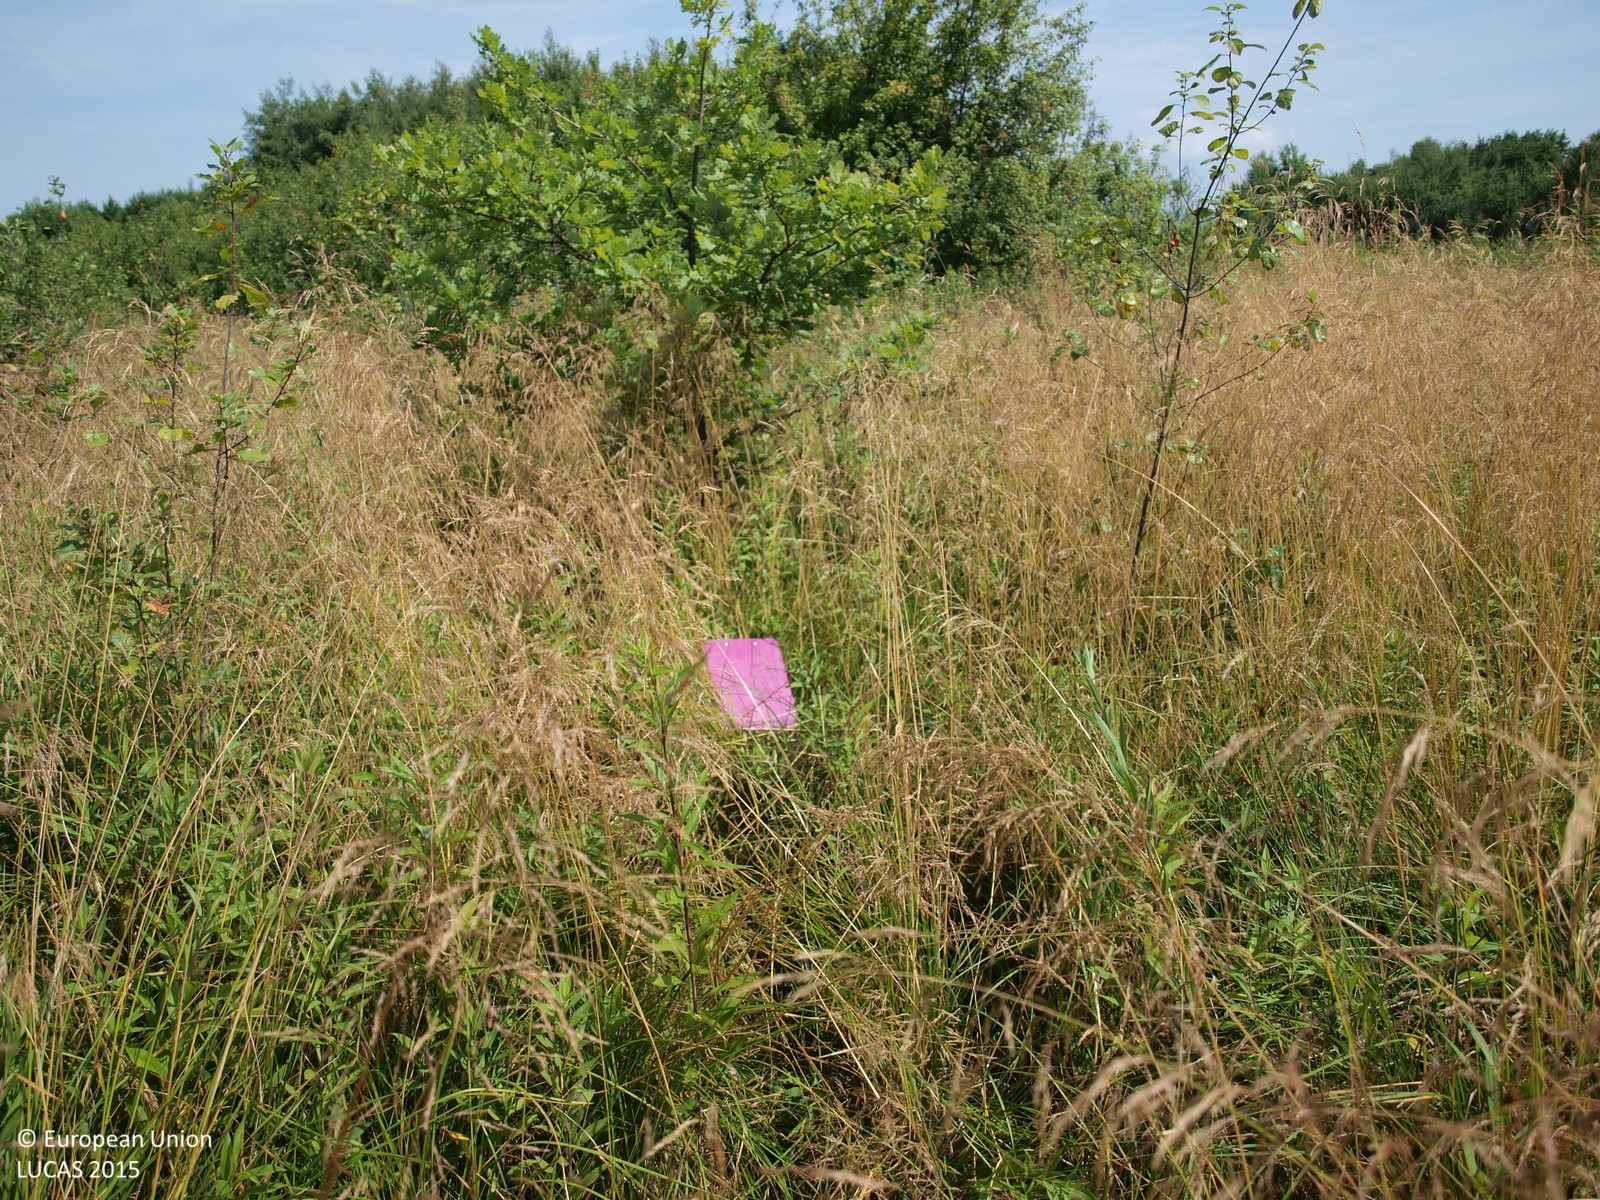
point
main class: Grassland
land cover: Grassland with sparse tree/shrub cover
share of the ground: > 75 %
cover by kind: herbaceous plants 90 %, broadleaved forest trees 5 %, shrubs 5 %
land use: Fallow land
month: July
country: HR
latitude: 45.7399
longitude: 15.8452
